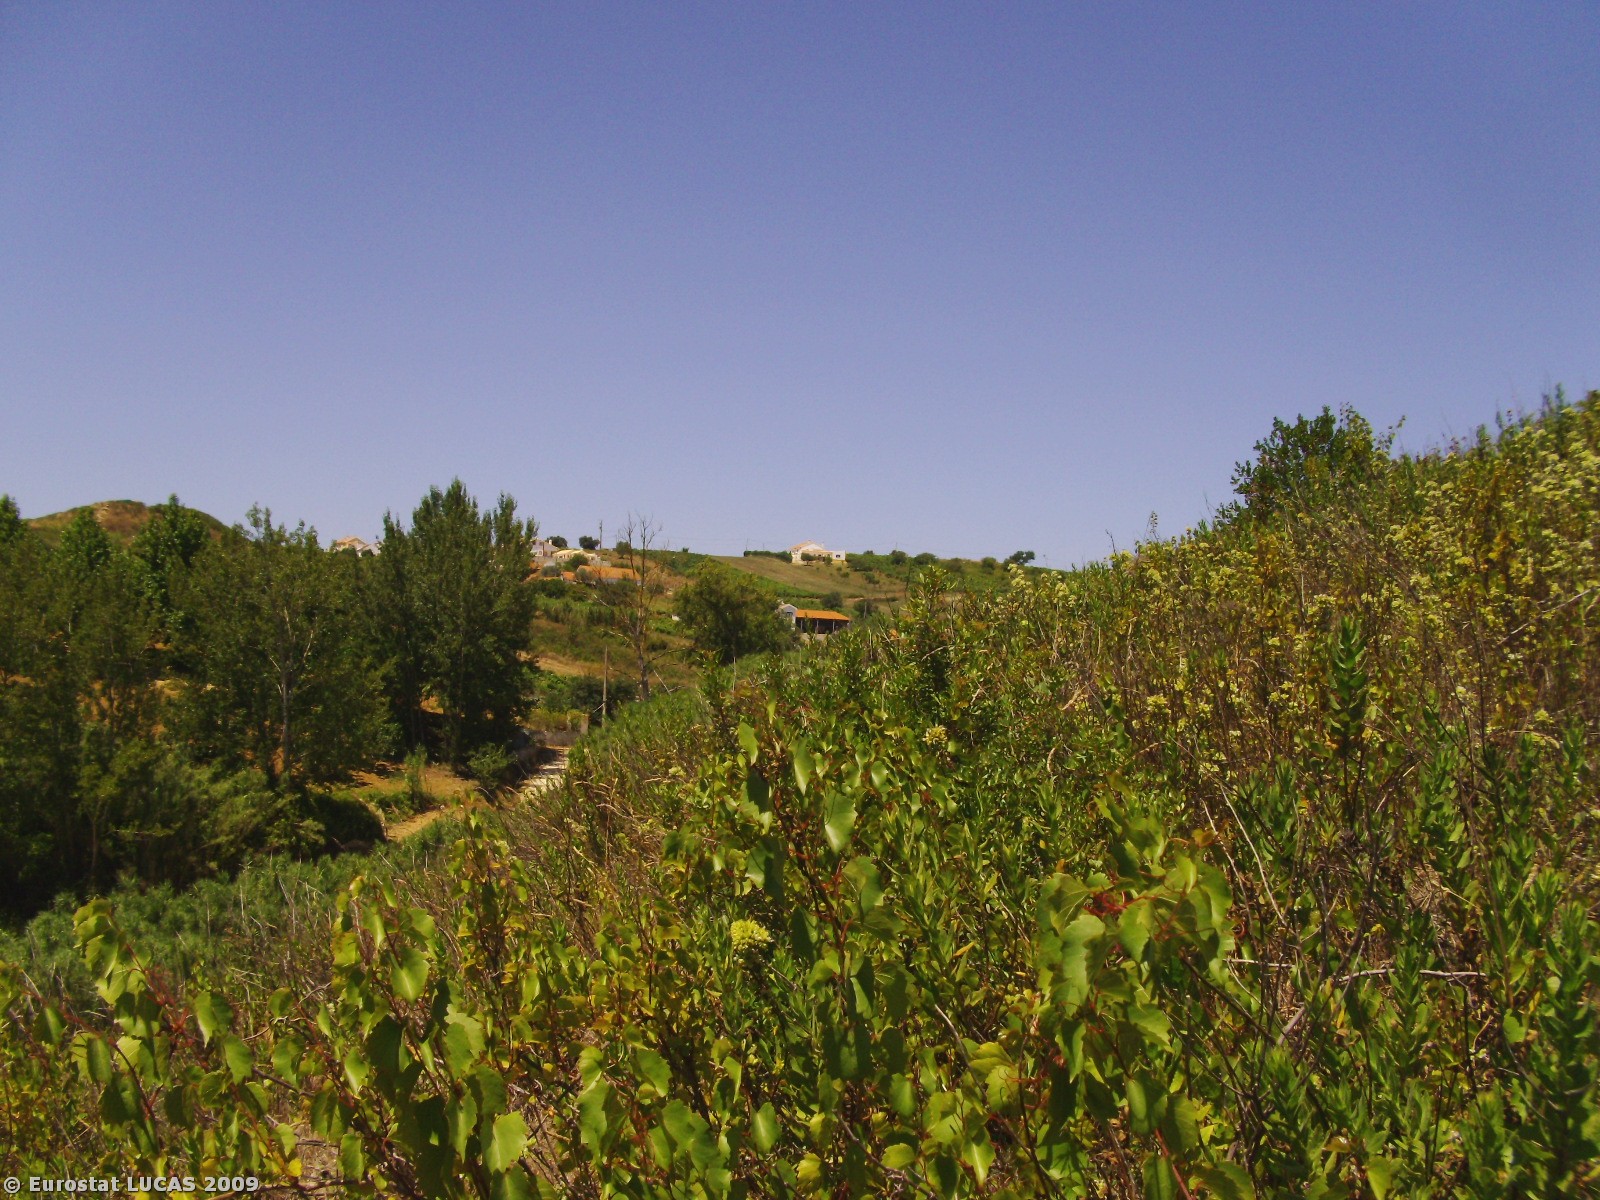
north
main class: Shrubland
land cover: Shrubland without tree cover
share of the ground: > 75 %
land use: Unused
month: July
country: PT
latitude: 39.0851
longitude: -9.0509
